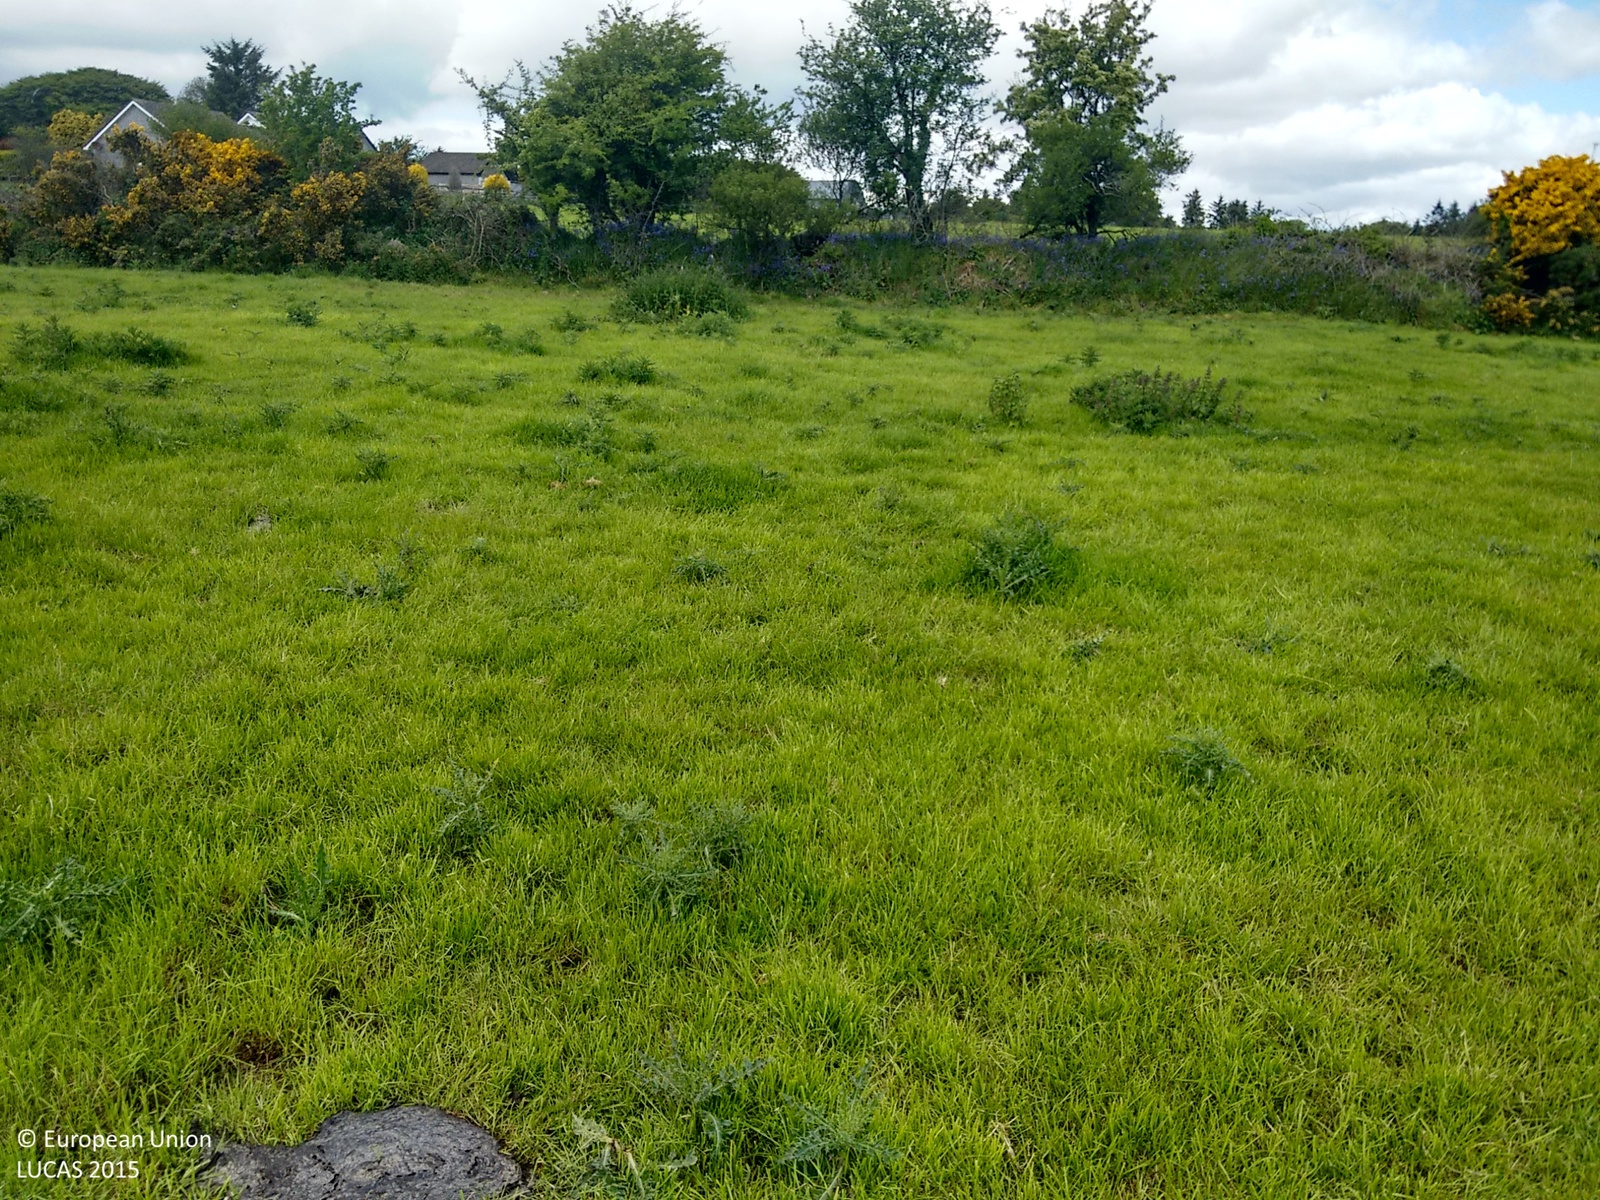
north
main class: Grassland
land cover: Grassland without tree/shrub cover
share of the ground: > 75 %
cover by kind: herbaceous plants 100 %
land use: Agriculture (excluding fallow land and kitchen gardens)
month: May
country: IE
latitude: 51.8229
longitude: -8.7601
